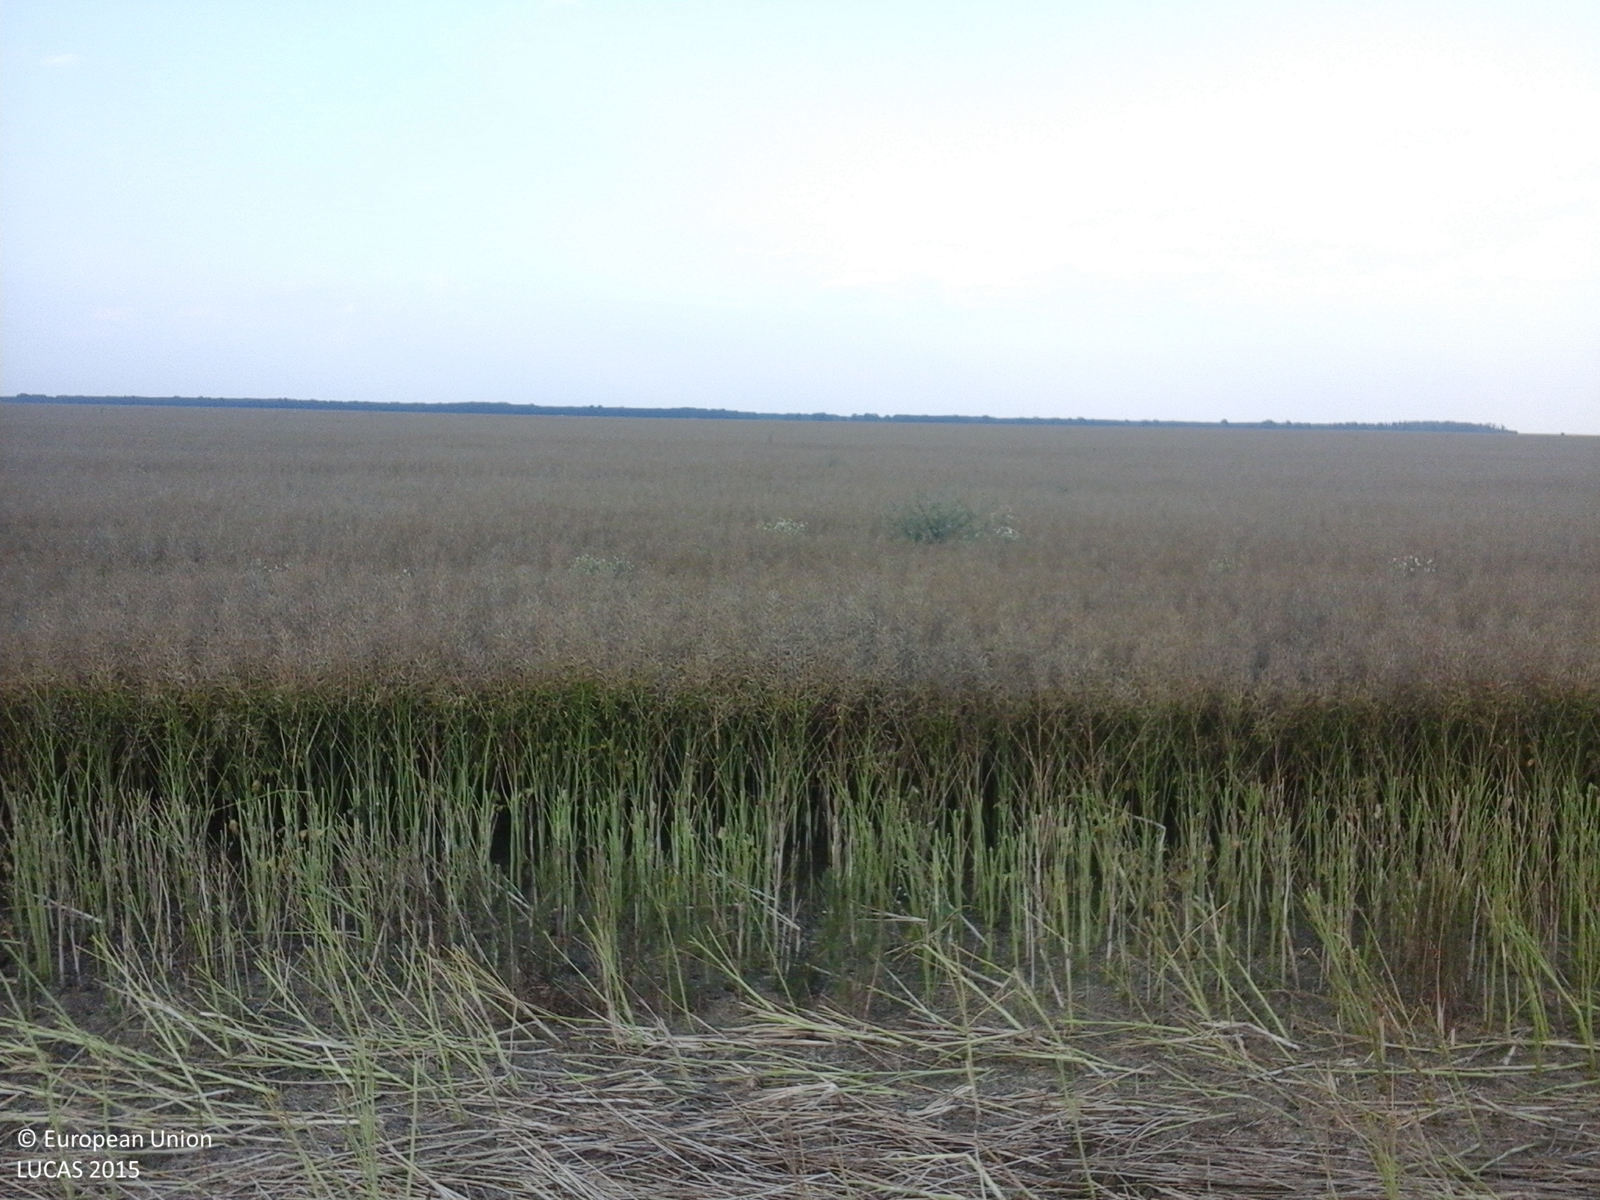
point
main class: Cropland
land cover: Rape and turnip rape
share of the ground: > 75 %
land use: Agriculture (excluding fallow land and kitchen gardens)
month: July
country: RO
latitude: 43.9472
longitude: 24.7611
